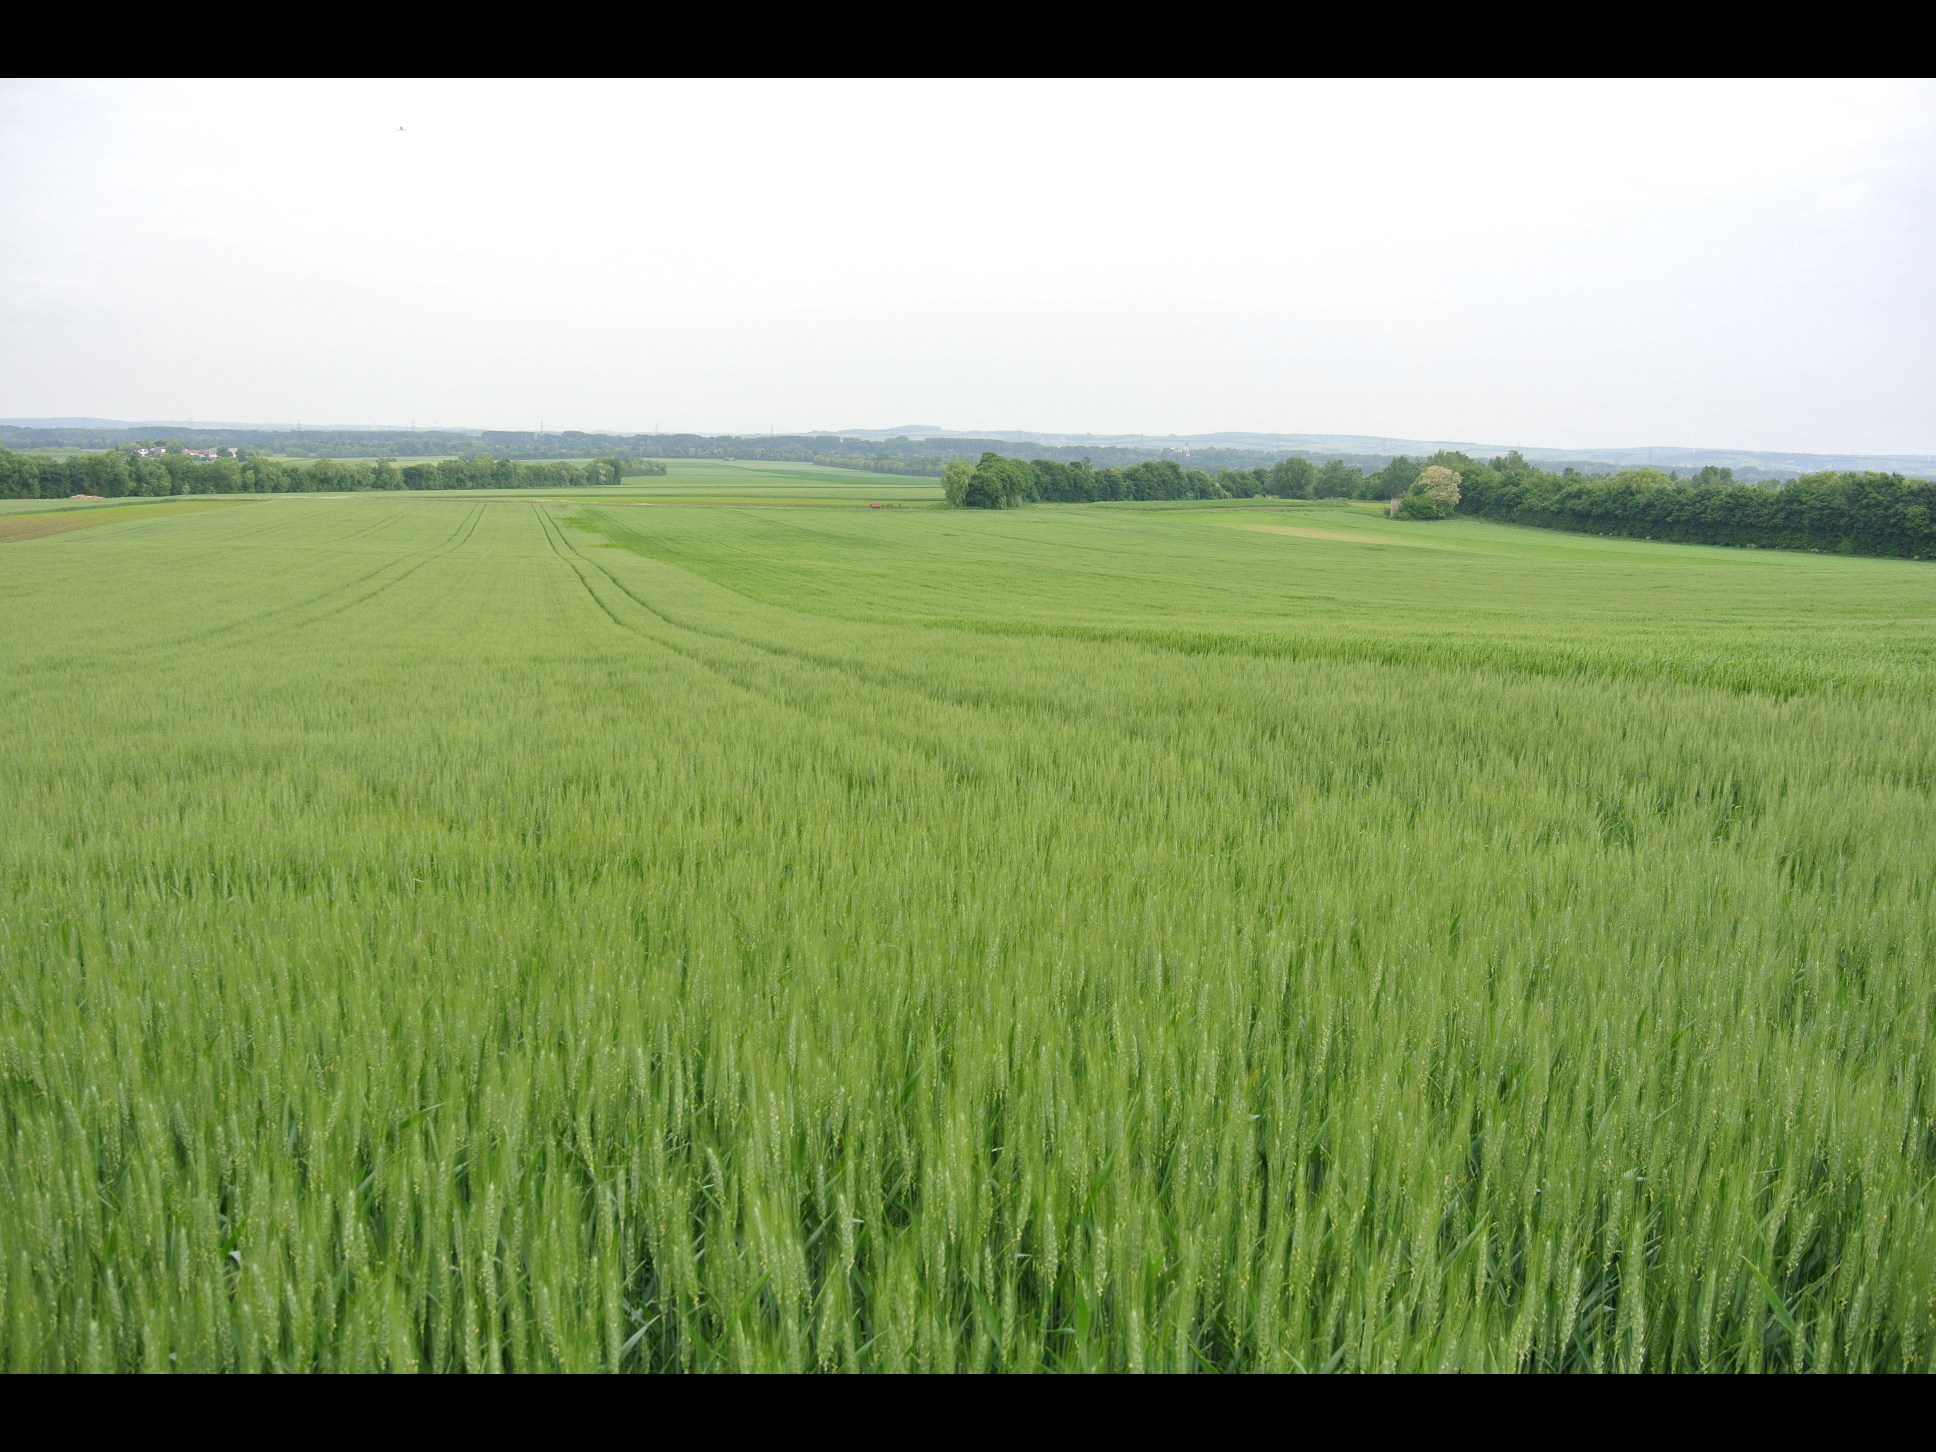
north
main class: Cropland
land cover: Durum wheat
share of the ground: > 75 %
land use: Agriculture (excluding fallow land and kitchen gardens)
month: May
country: AT
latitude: 47.9873
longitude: 16.6382
